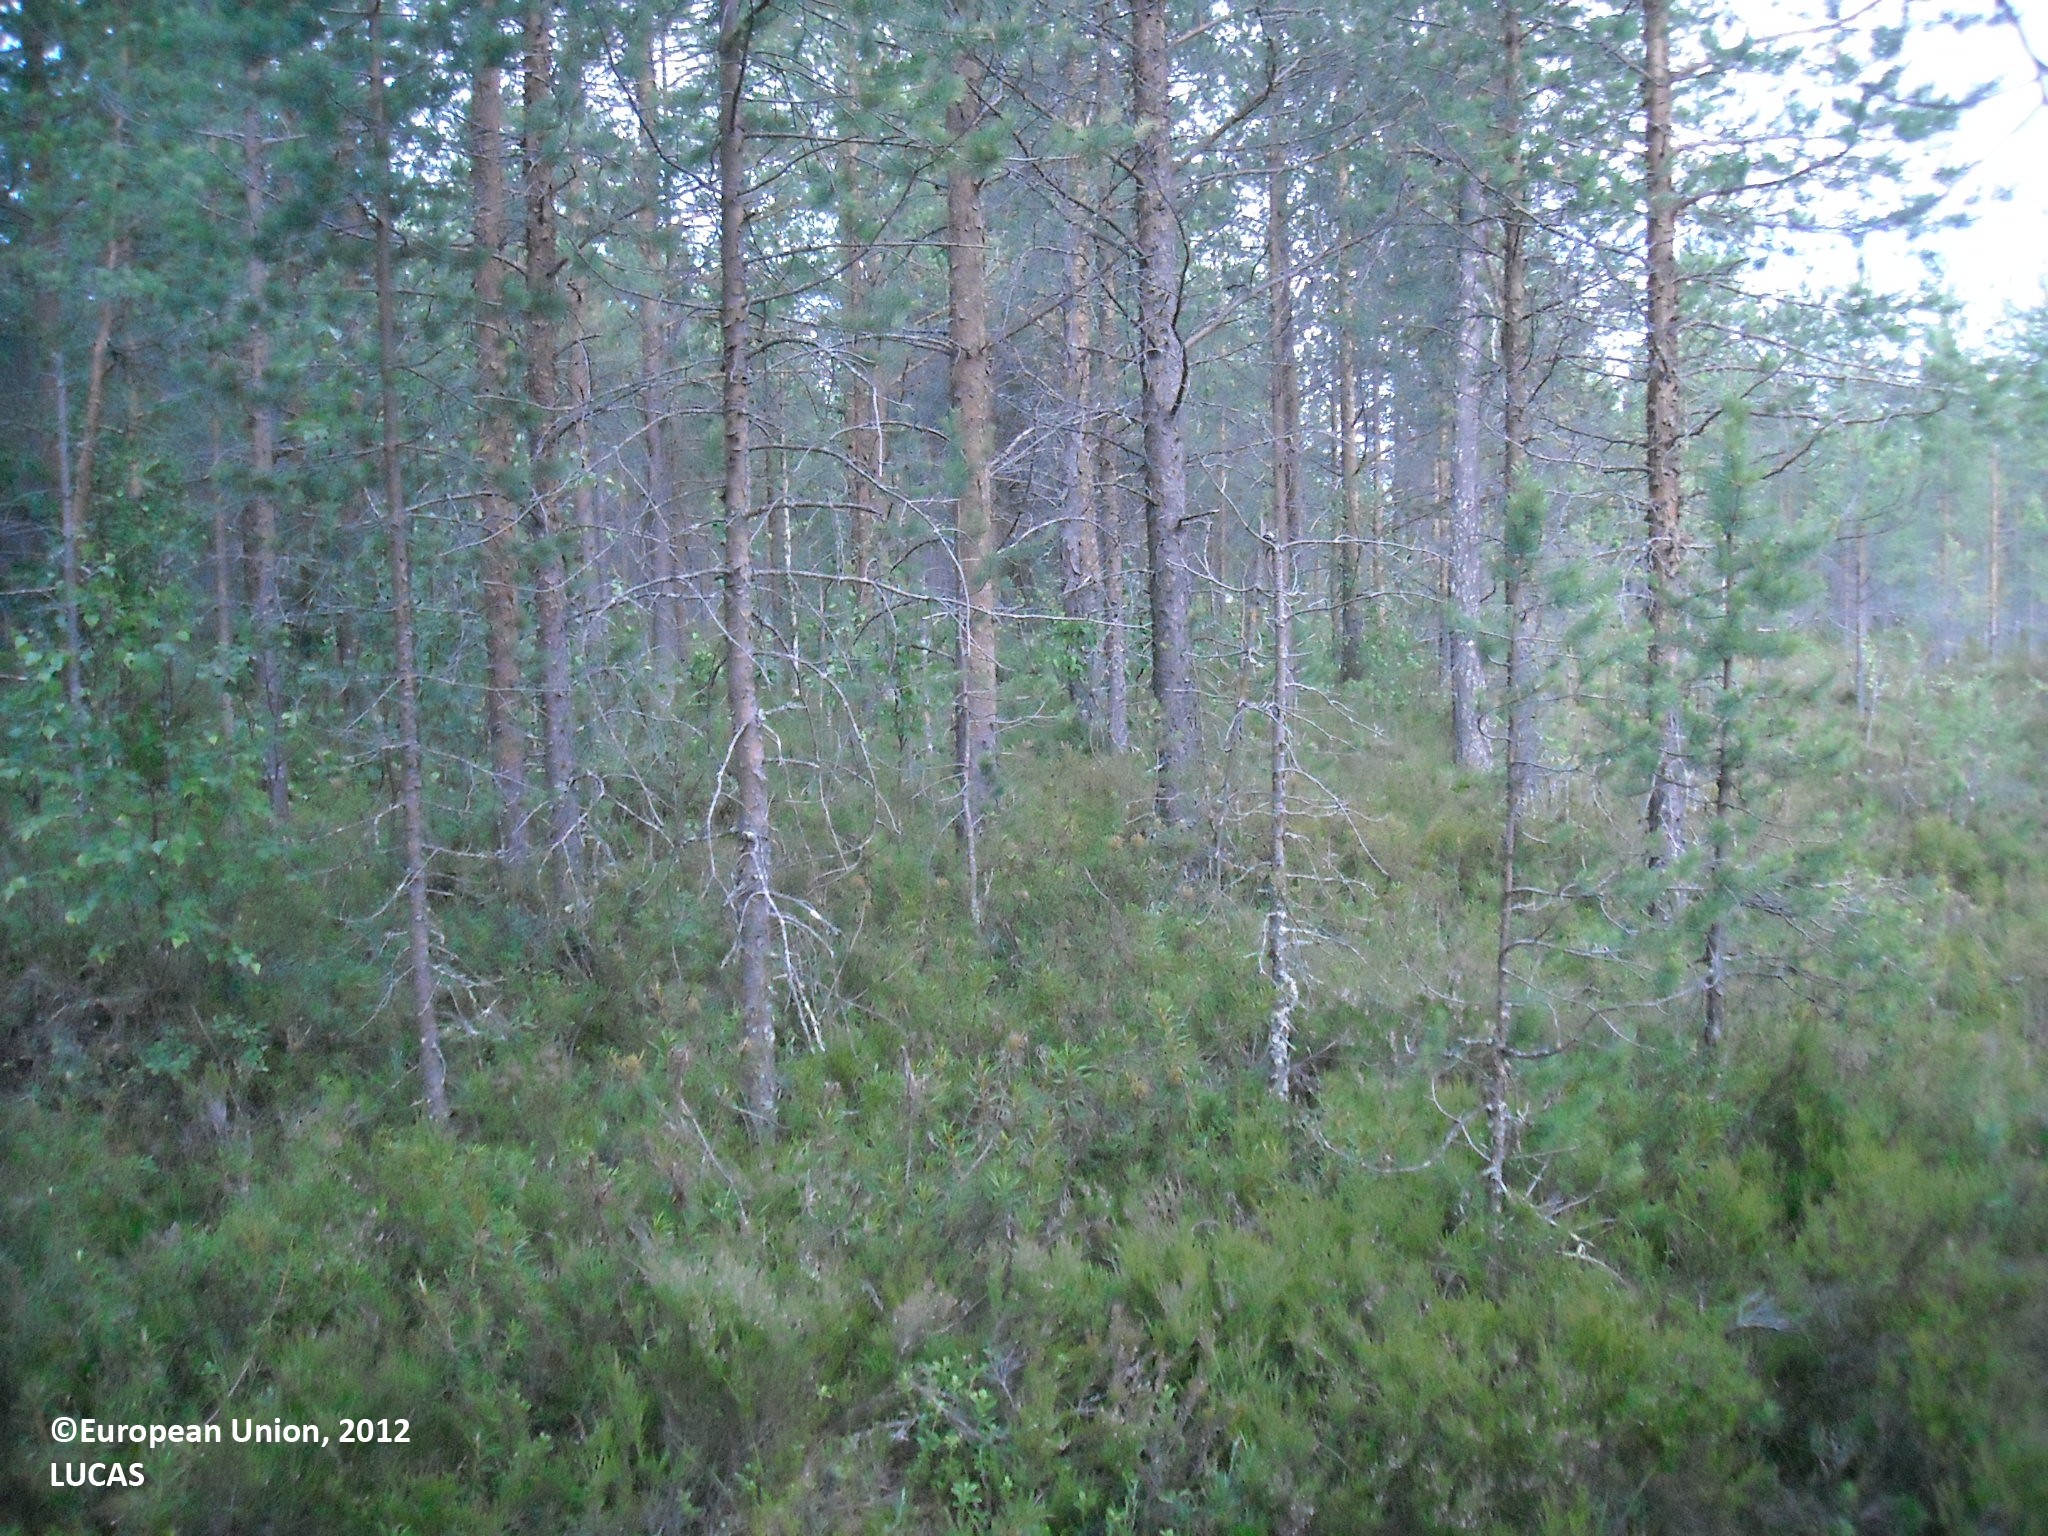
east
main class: Woodland
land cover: Pine dominated coniferous woodland
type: mire and swamp forests
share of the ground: 50 - 75 %
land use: Forestry
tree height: > 5 m
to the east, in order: Pine dominated coniferous woodland; Ditches and canals; Pine dominated coniferous woodland; Ditches and canals; Pine dominated coniferous woodland; Ditches and canals; Pine dominated coniferous woodland
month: July
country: FI
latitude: 65.0703
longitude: 26.8065
